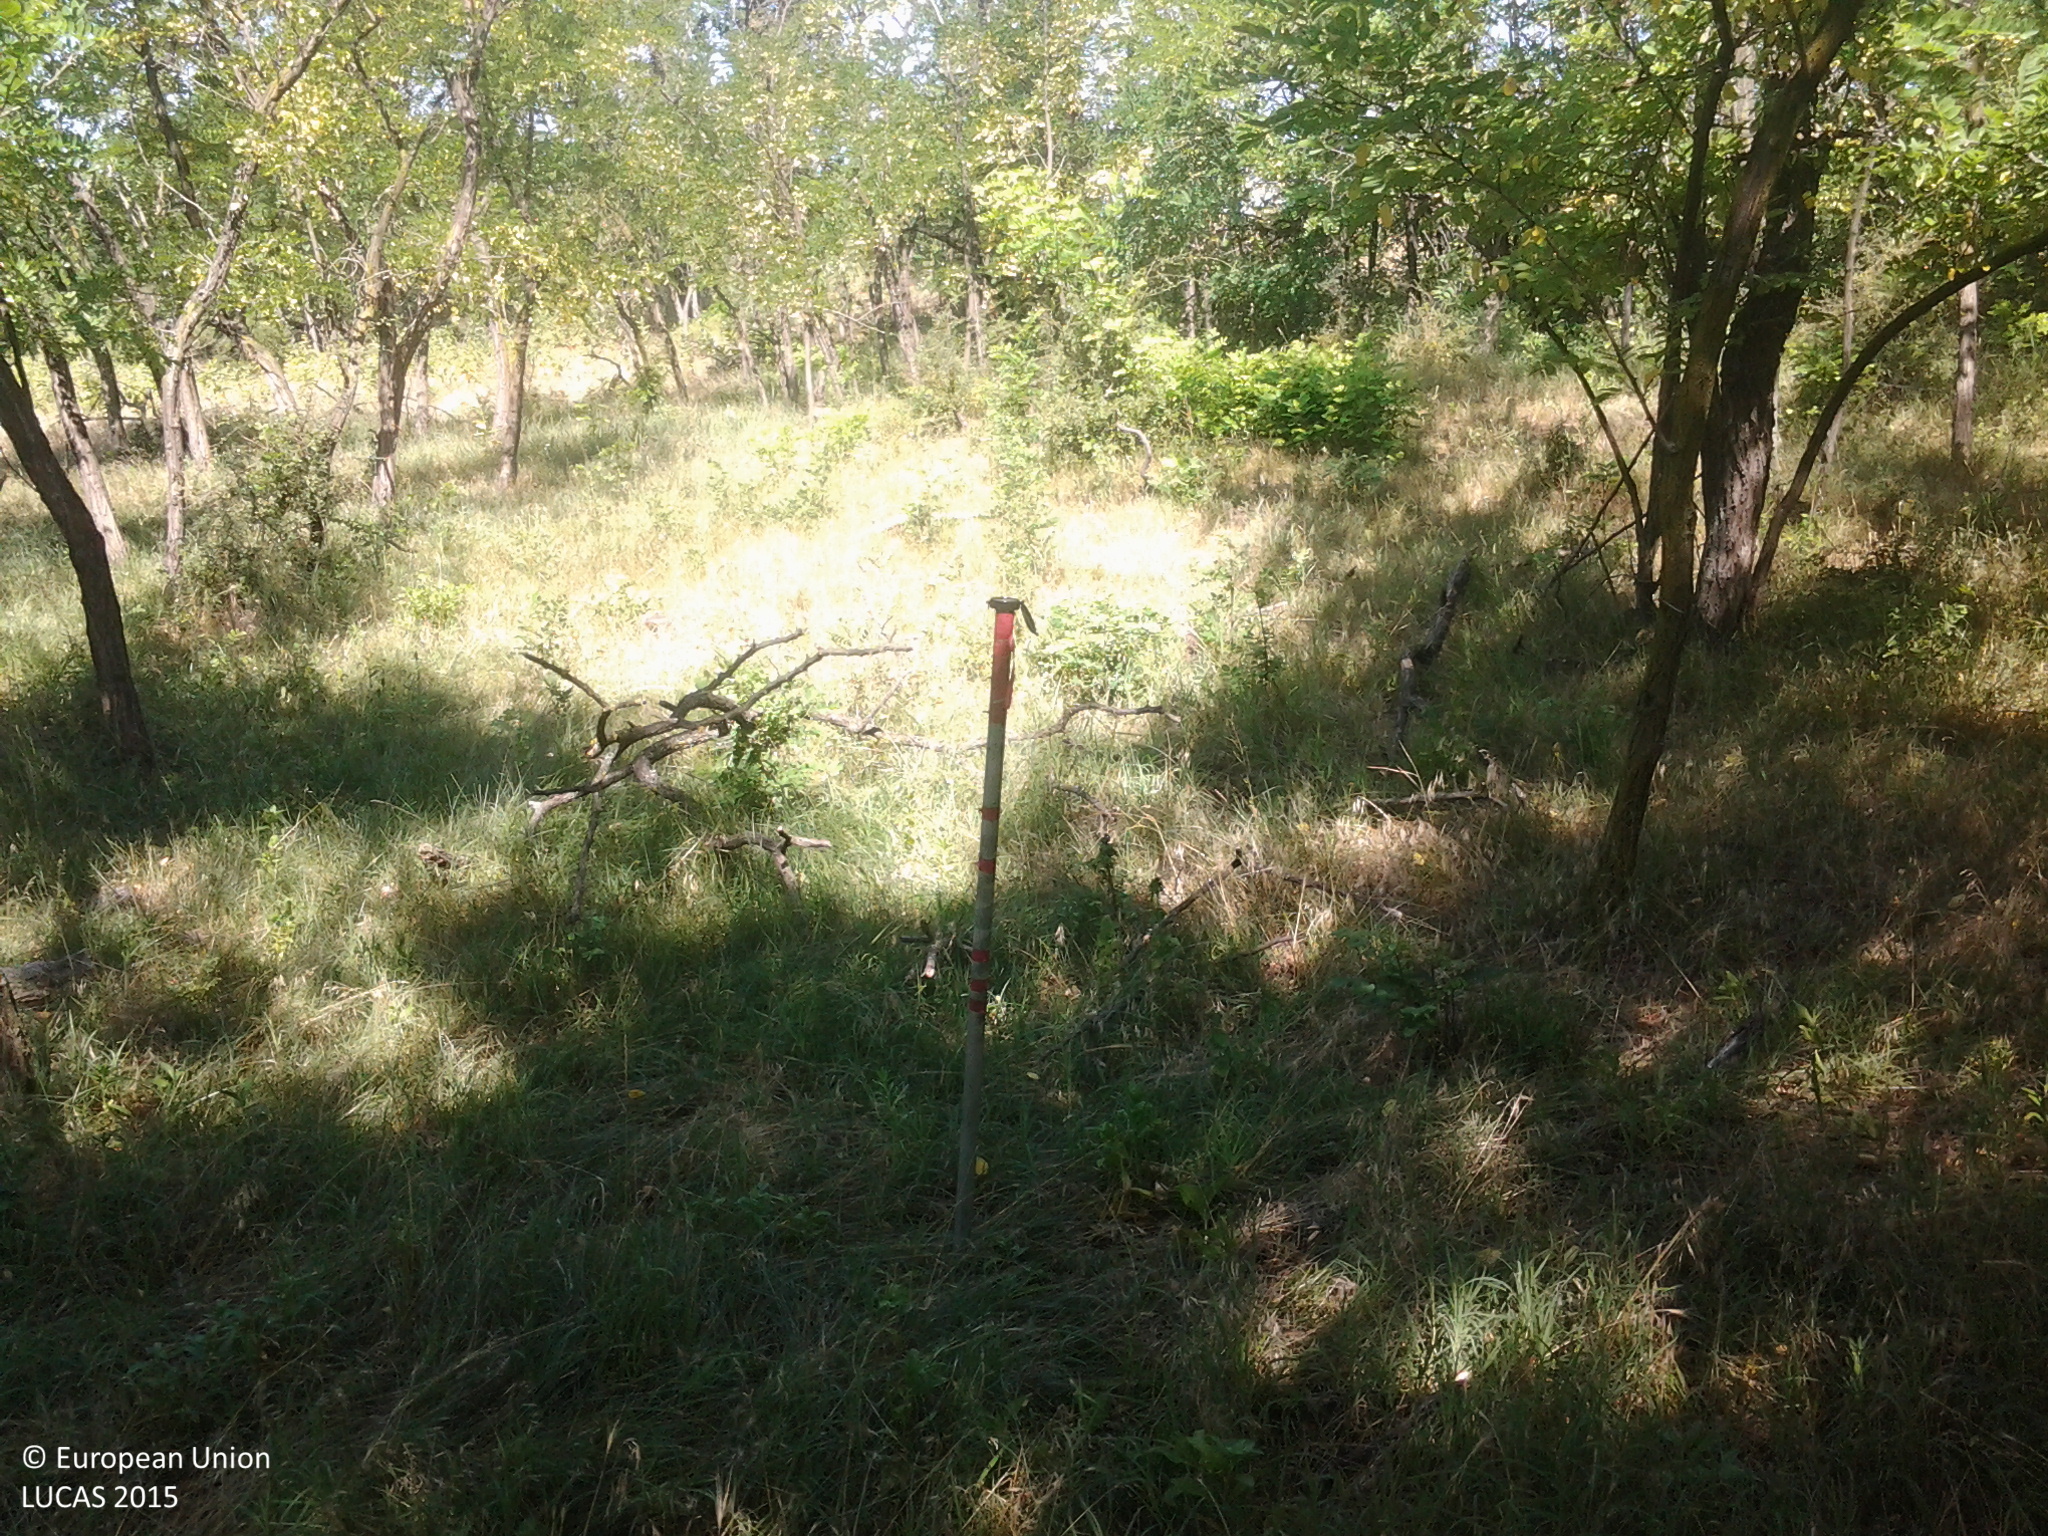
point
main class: Woodland
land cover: Broadleaved woodland
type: exotic forest
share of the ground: 50 - 75 %
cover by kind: broadleaved forest trees 70 %, herbaceous plants 30 %
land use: Forestry
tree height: > 5 m
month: July
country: HU
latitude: 46.5395
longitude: 19.5500
